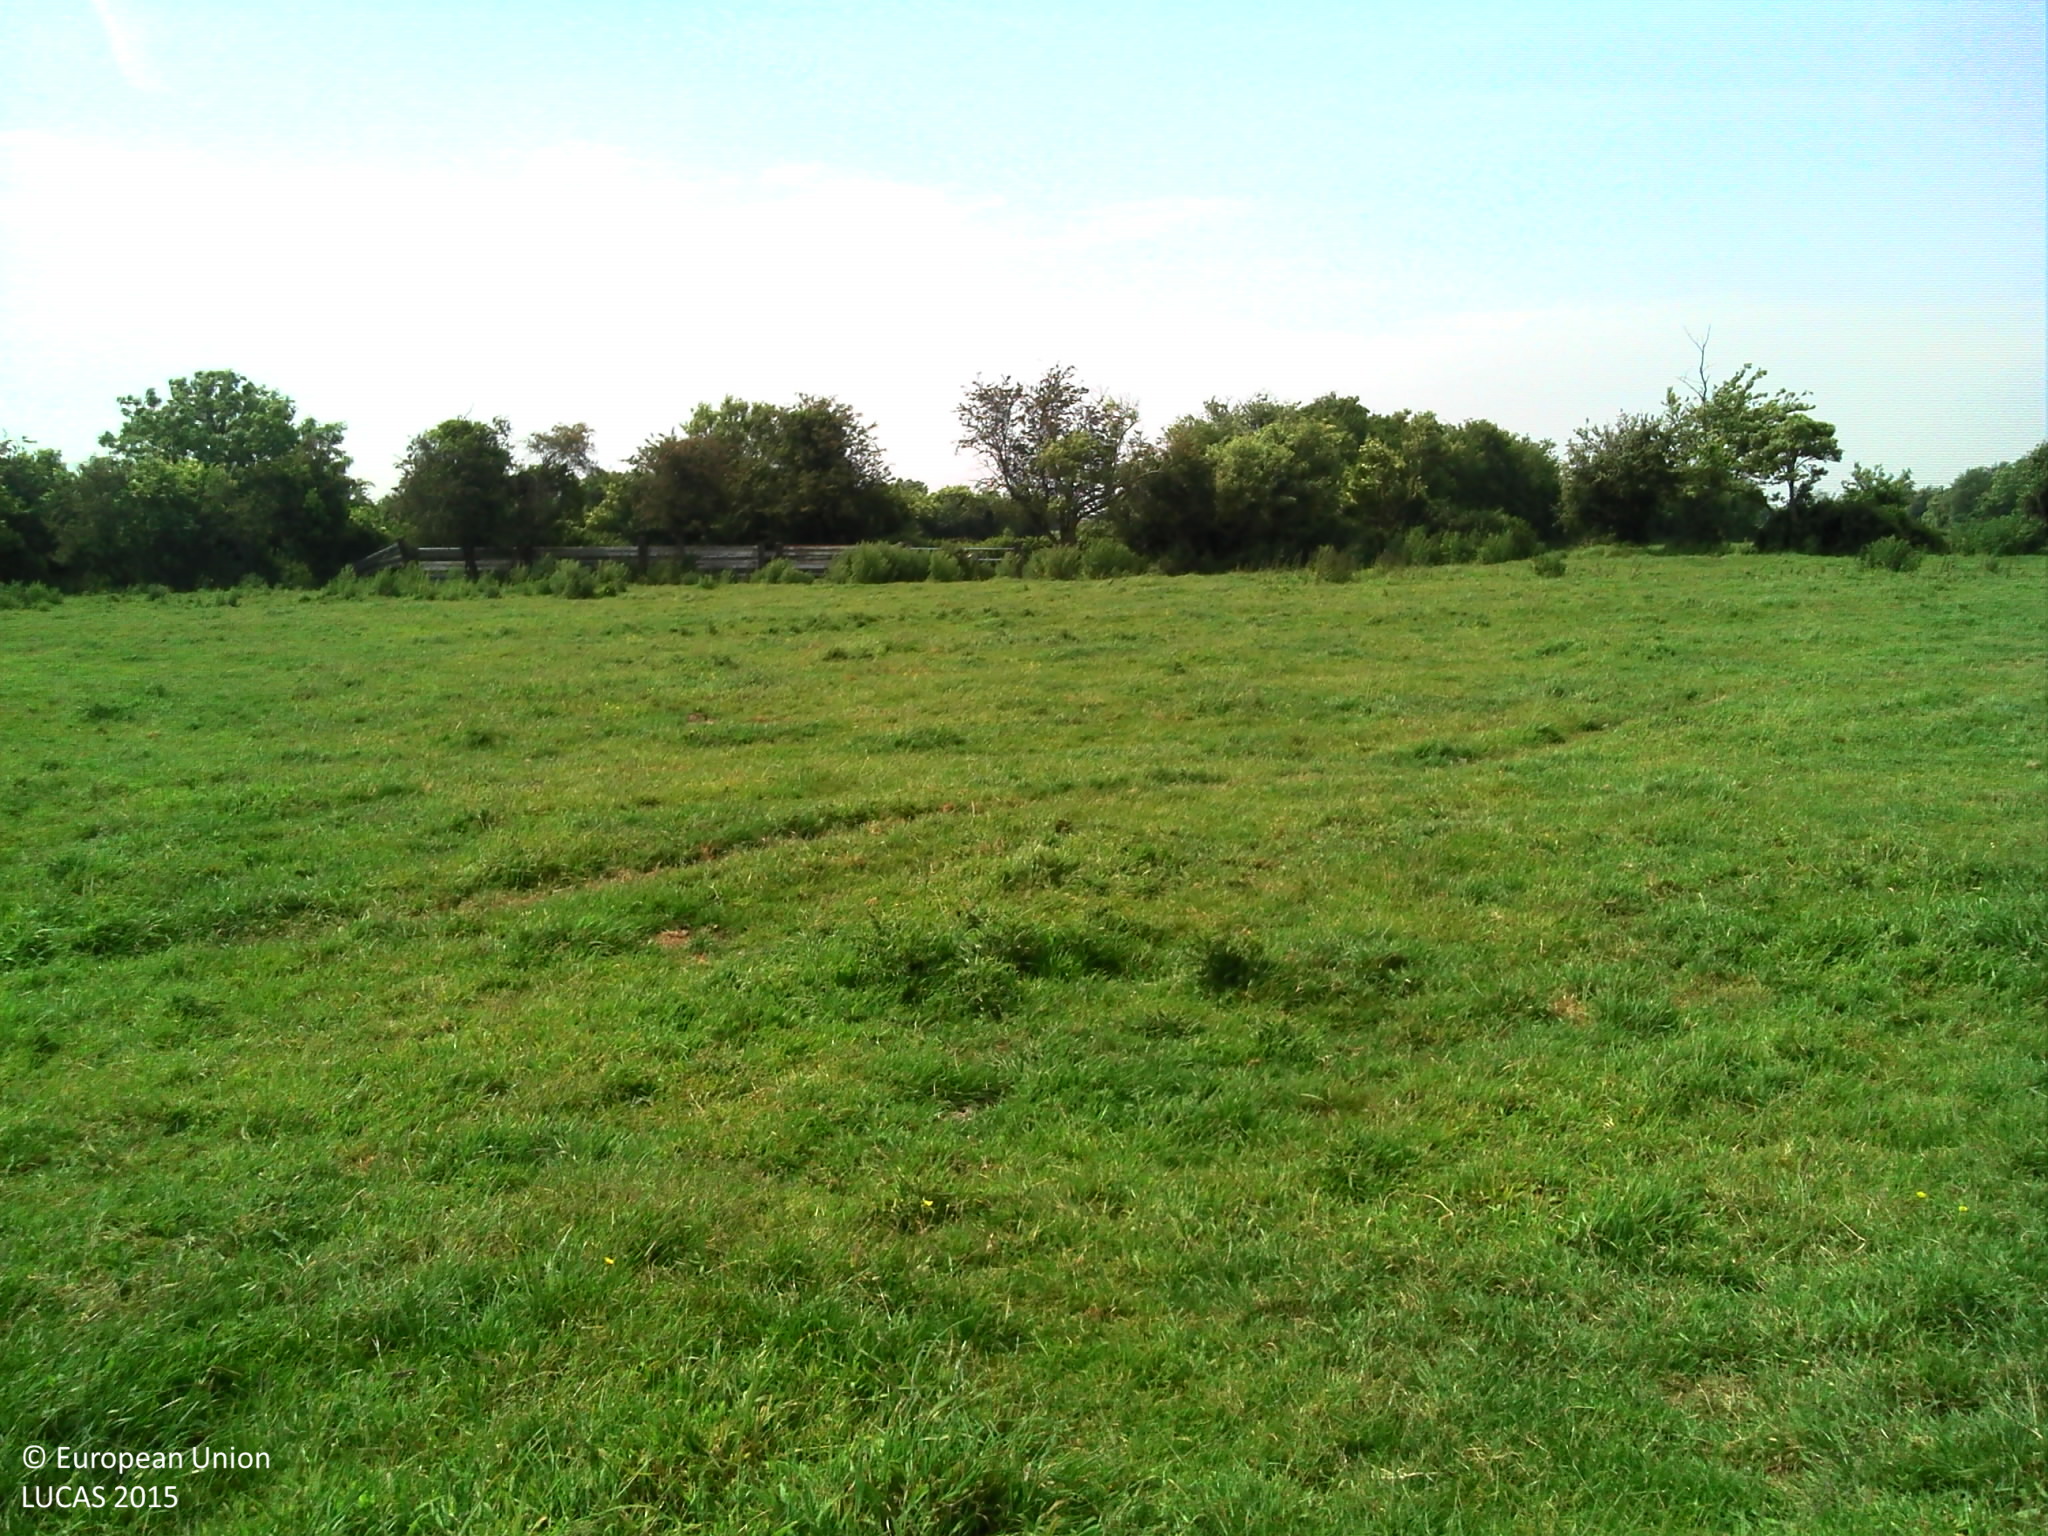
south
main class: Grassland
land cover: Grassland without tree/shrub cover
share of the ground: > 75 %
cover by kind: herbaceous plants 100 %
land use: Agriculture (excluding fallow land and kitchen gardens)
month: June
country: FR
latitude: 49.4469
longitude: -1.3996
